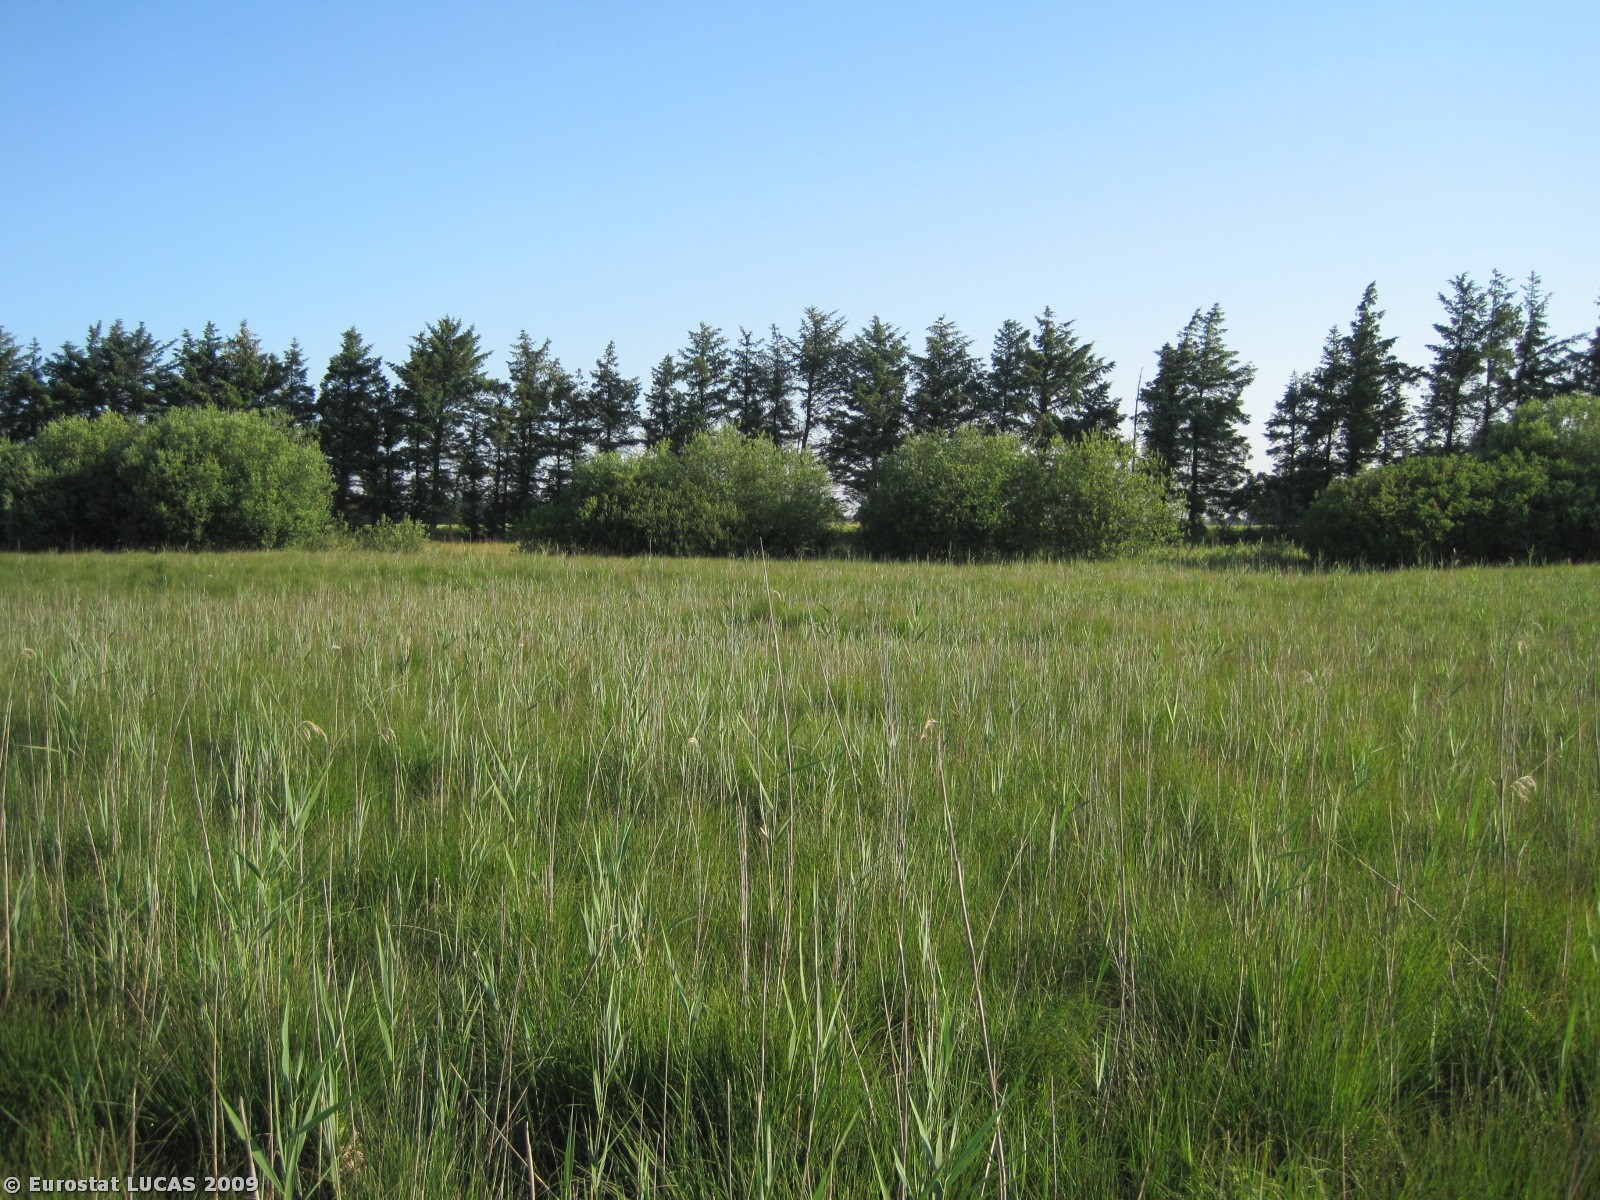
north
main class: Wetlands
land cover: Inland marshes
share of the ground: > 75 %
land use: Unused
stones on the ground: < 10 %
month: July
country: DK
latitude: 56.3739
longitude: 8.2695
